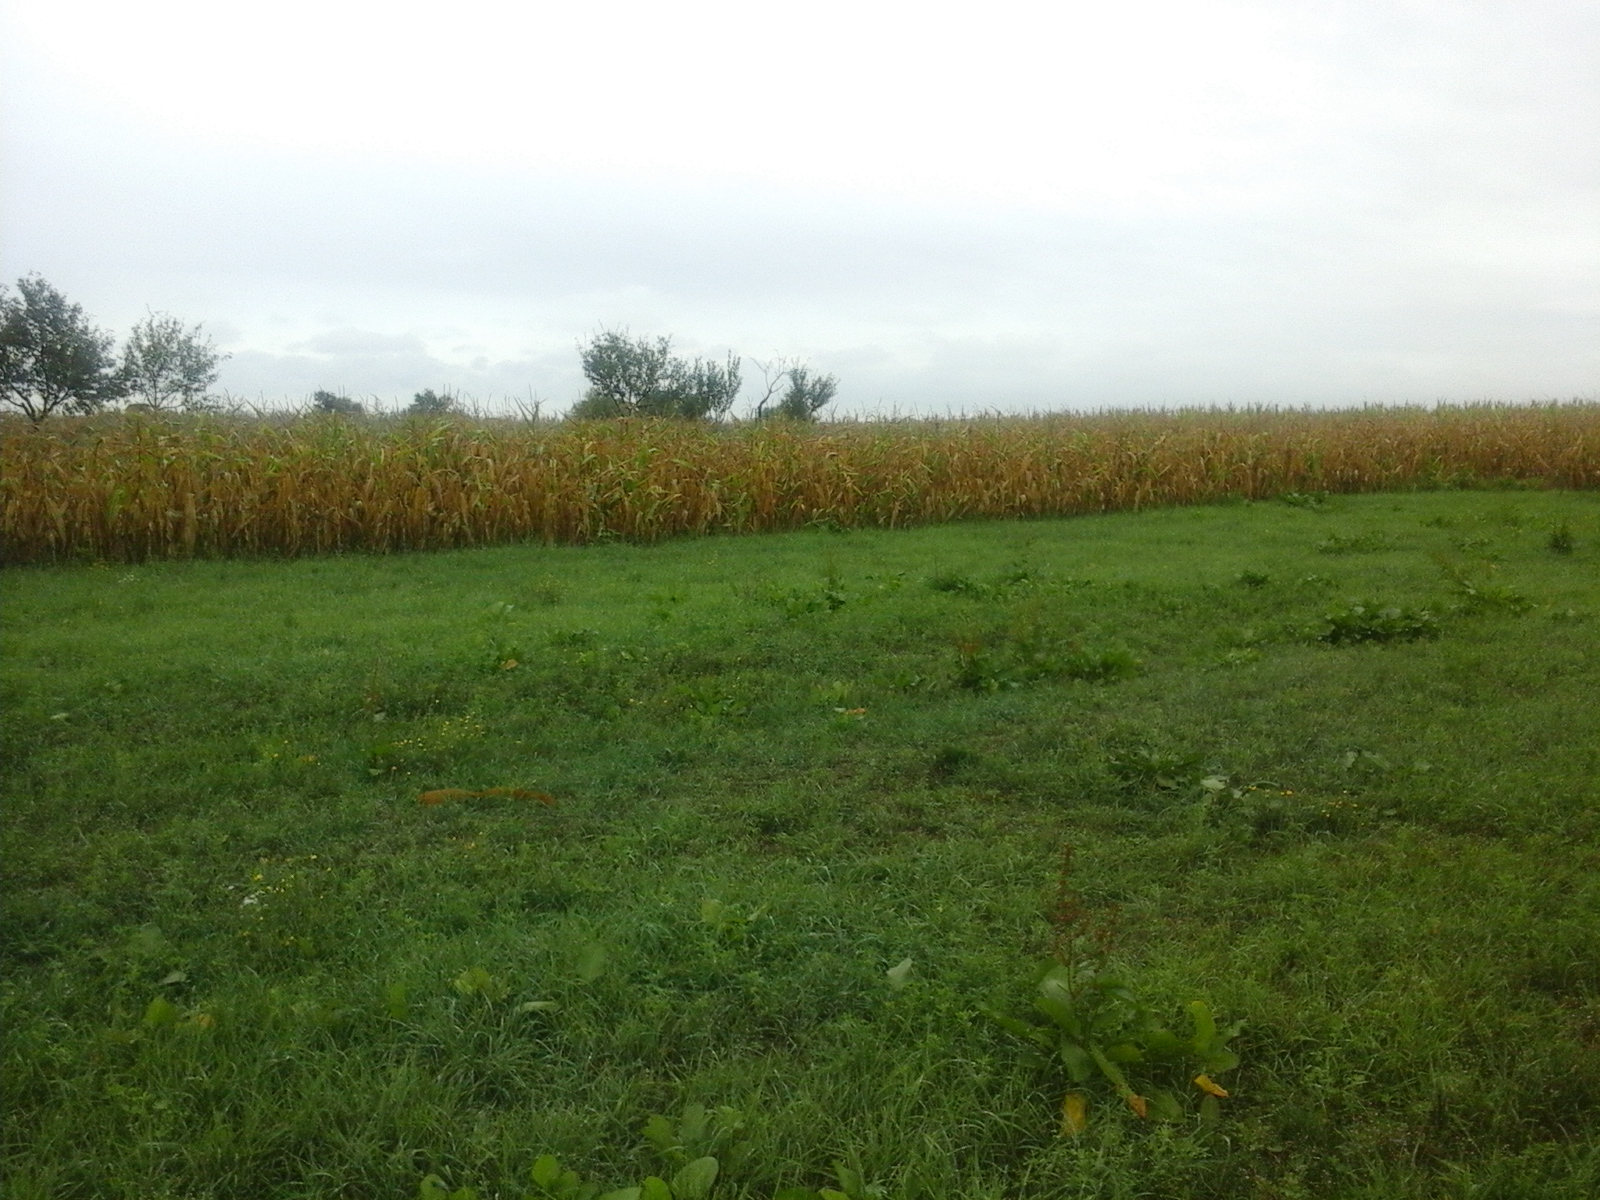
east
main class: Cropland
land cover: Lucerne
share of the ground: > 75 %
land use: Agriculture (excluding fallow land and kitchen gardens)
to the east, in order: Lucerne; Maize; Vineyards; Maize; Other bare soil; Abandoned hedges; Spontaneously vegetated surfaces
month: September
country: RO
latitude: 47.0299
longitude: 21.7415
